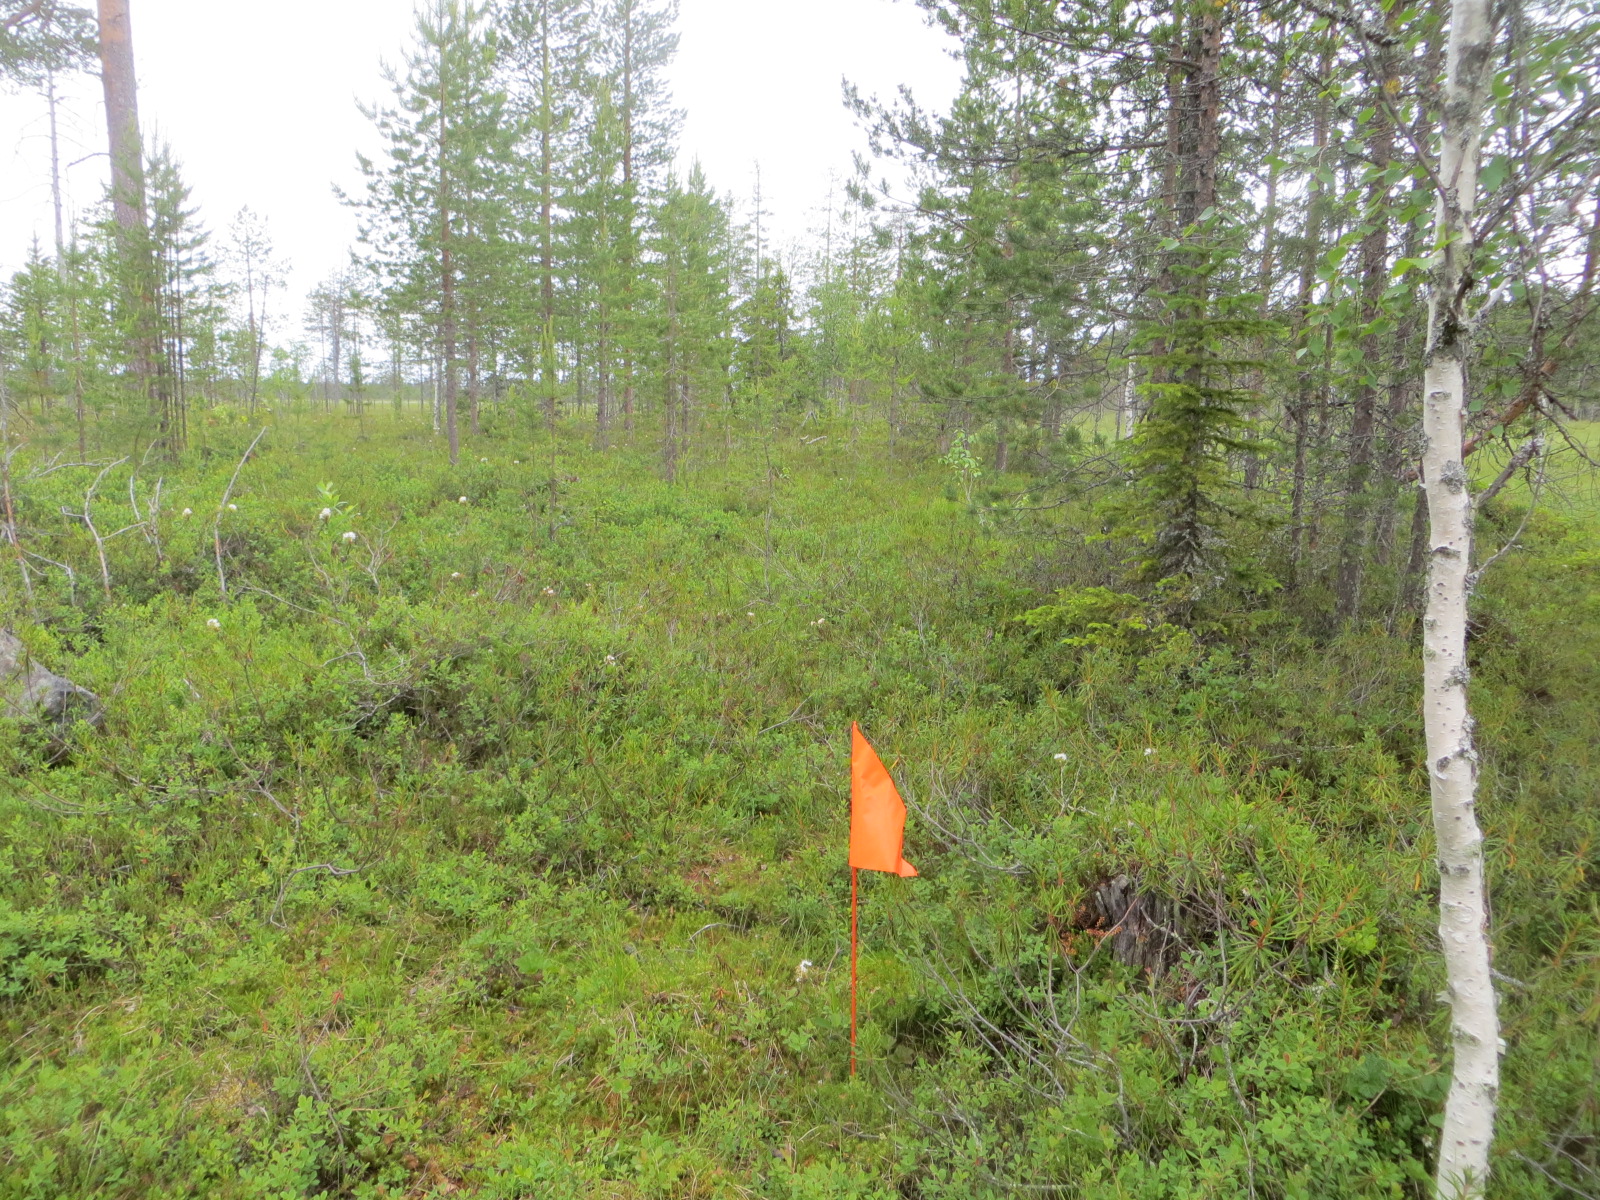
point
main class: Woodland
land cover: Pine dominated coniferous woodland
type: boreal forest
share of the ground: > 75 %
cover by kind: coniferous forest trees 75 %, shrubs 20 %, broadleaved forest trees 5 %
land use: Forestry
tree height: > 5 m
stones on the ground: 25 - 50 %
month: July
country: FI
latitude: 65.5765
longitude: 25.8416
